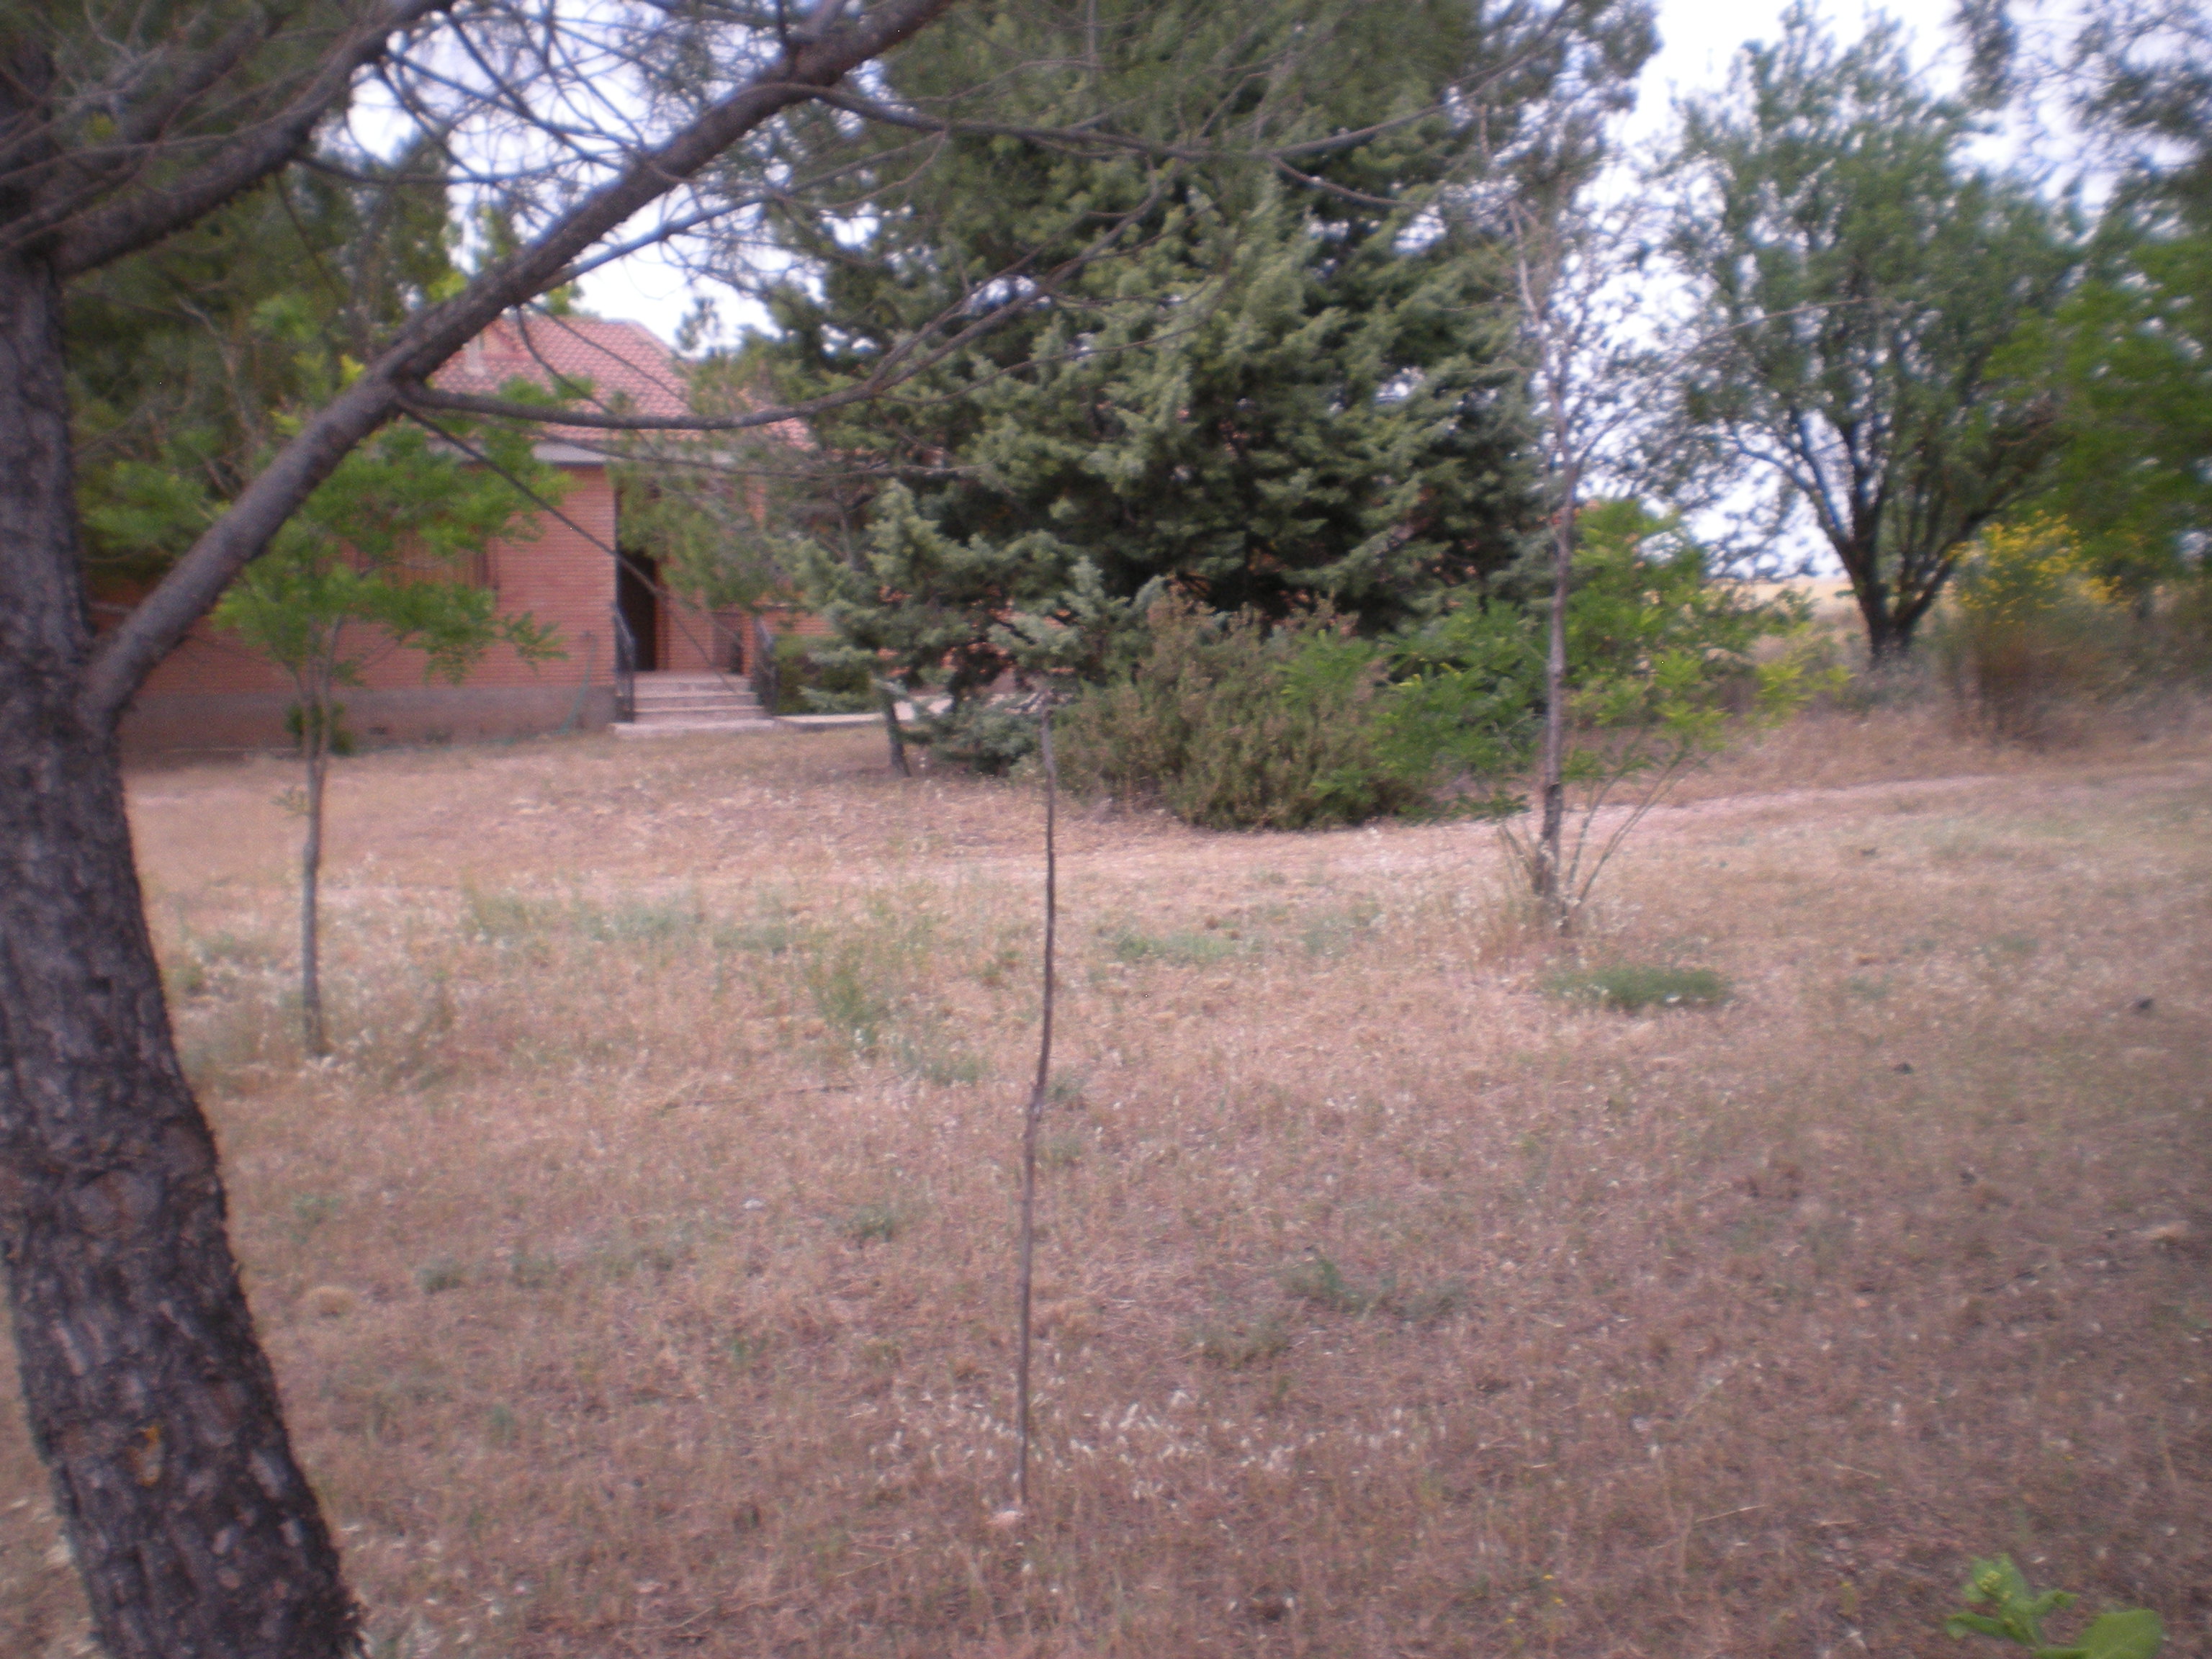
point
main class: Woodland
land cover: Pine dominated mixed woodland
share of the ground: 25 - 50 %
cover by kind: coniferous forest trees 30 %, unconsolidated bare surface 30 %, broadleaved forest trees 10 %, shrubs 10 %, herbaceous plants 10 %, consolidated bare surface 10 %
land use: Residential
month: May
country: ES
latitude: 39.0708
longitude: -3.6455
